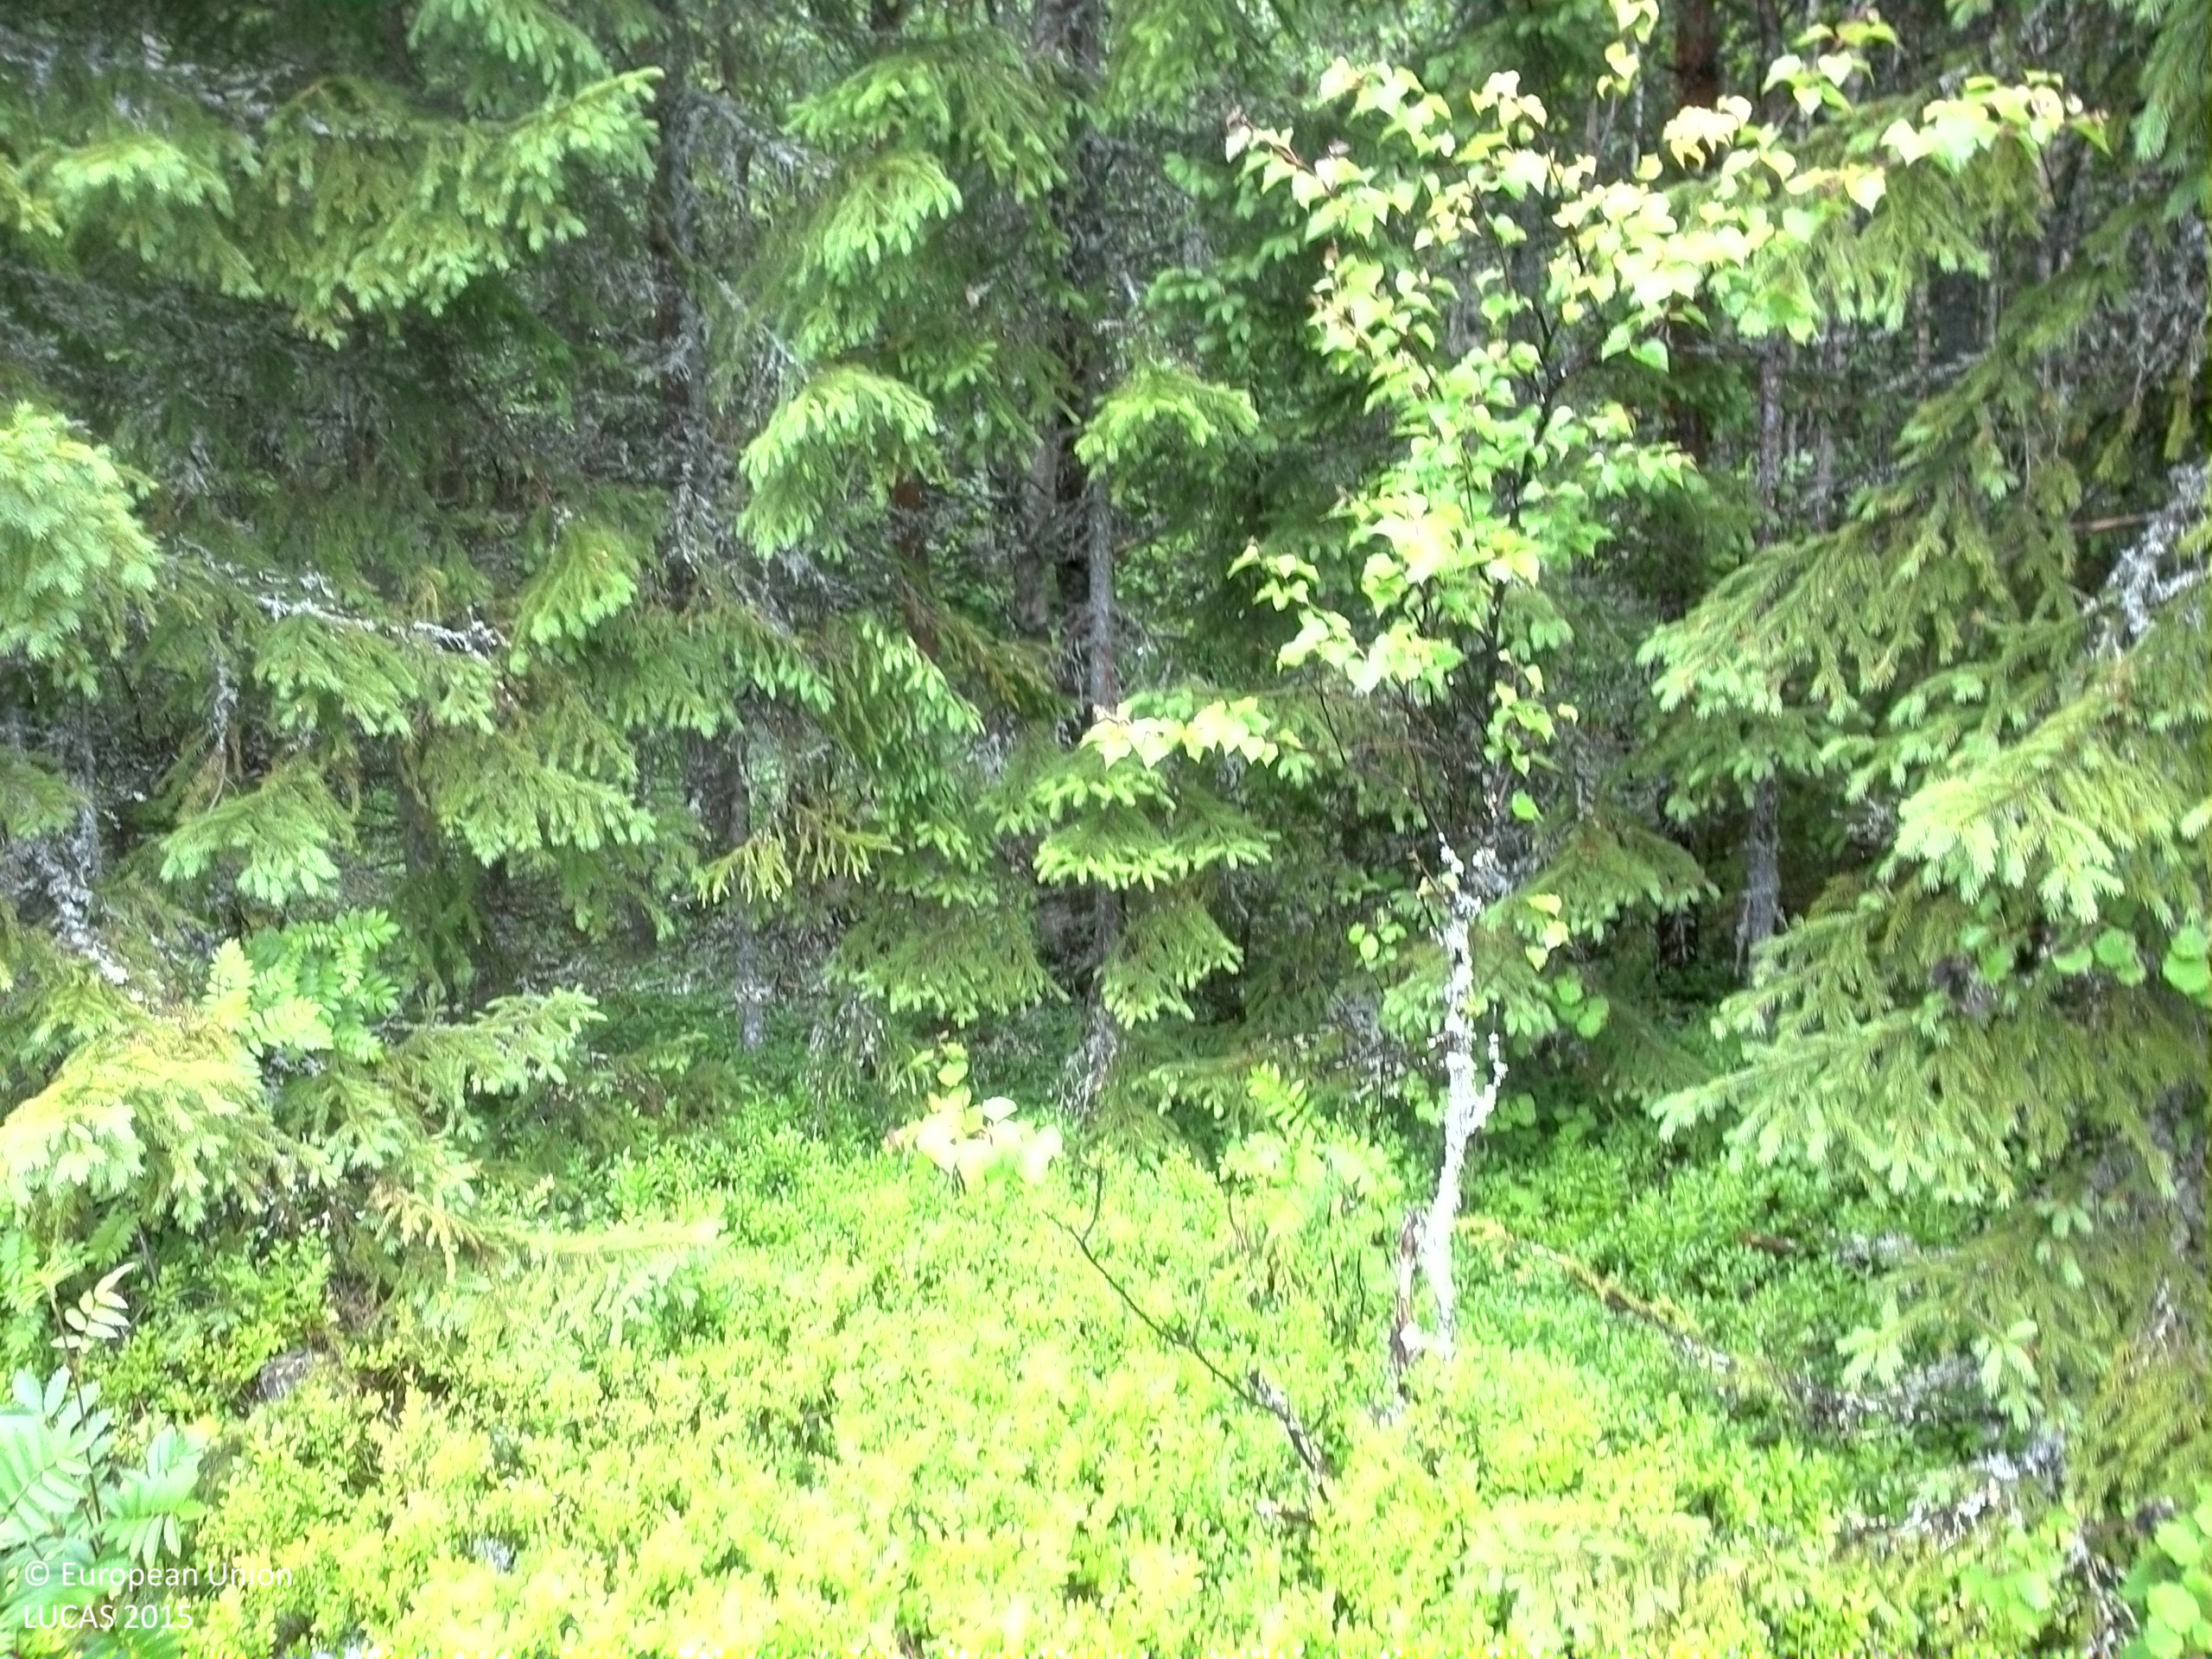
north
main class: Woodland
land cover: Spruce dominated mixed woodland
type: boreal forest
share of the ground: > 75 %
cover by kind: coniferous forest trees 50 %, broadleaved forest trees 30 %, shrubs 20 %
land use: Forestry
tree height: > 5 m
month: June
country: SE
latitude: 62.7469
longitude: 17.9464
